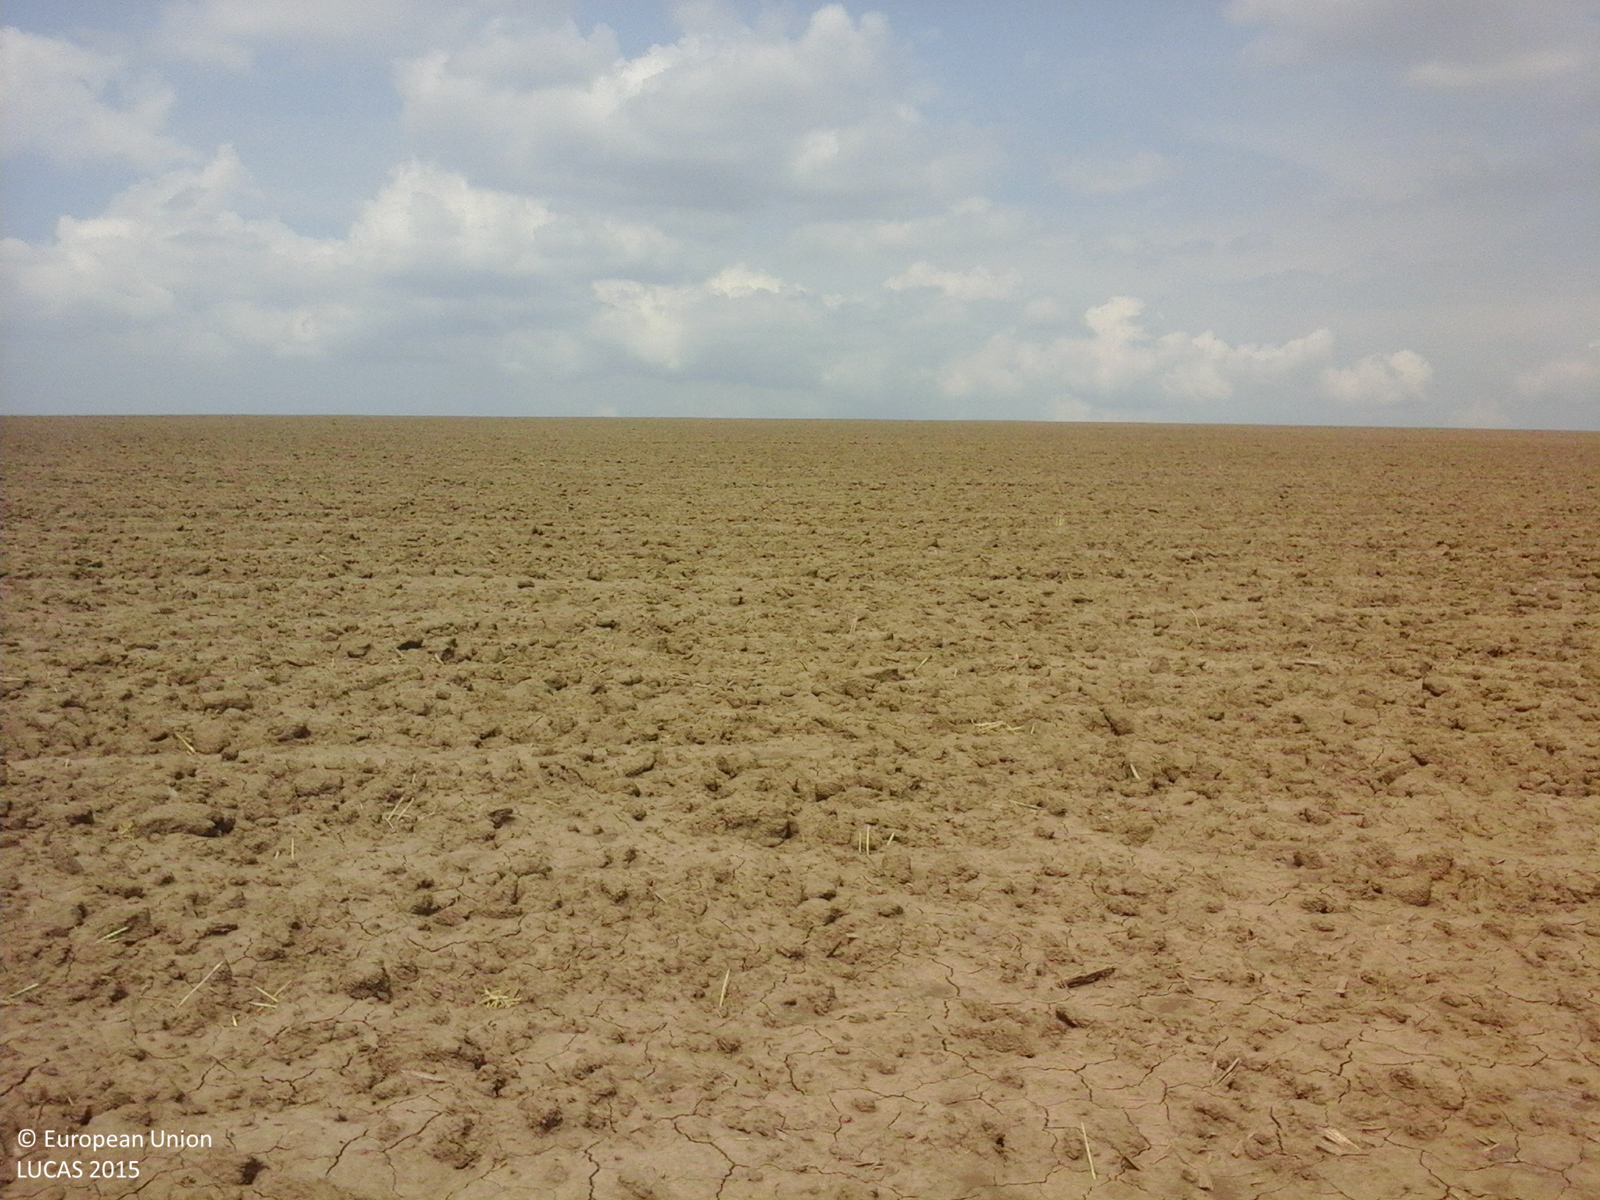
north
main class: Cropland
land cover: Common wheat
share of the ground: < 10 %
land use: Agriculture (excluding fallow land and kitchen gardens)
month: July
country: RO
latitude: 44.9798
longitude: 28.7929
